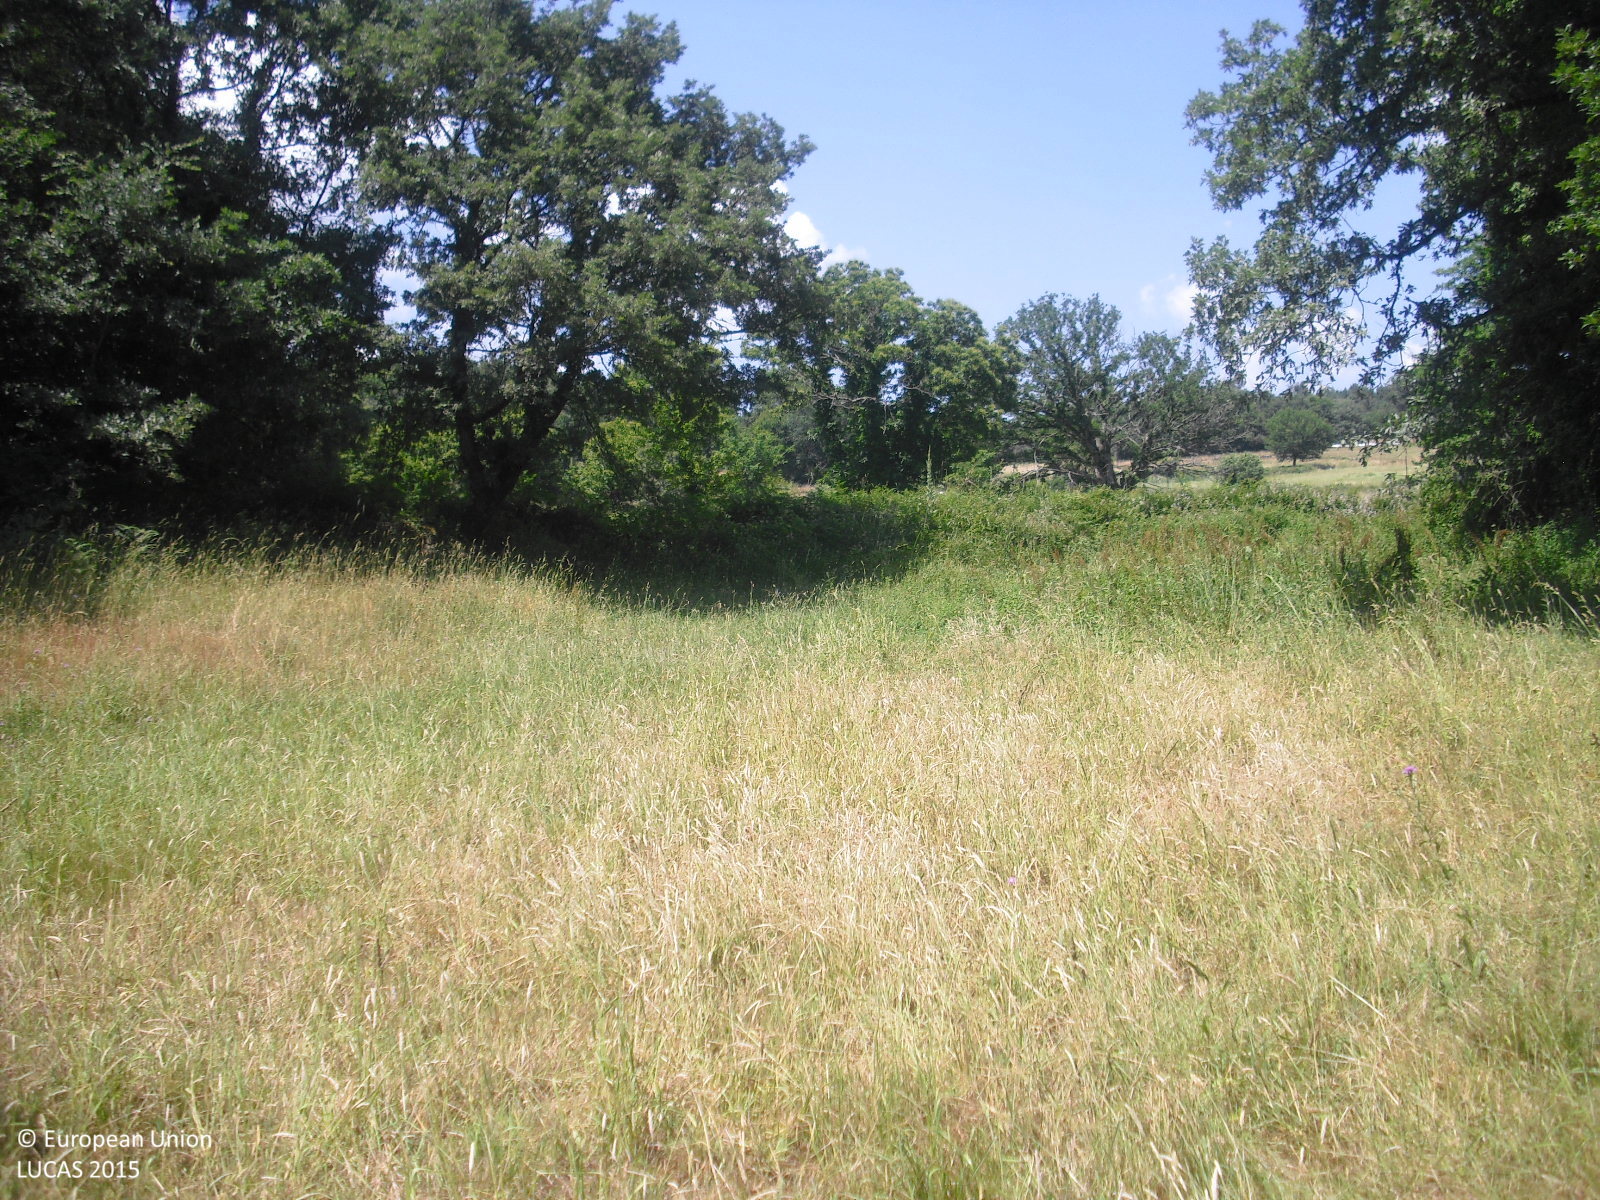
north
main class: Grassland
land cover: Grassland without tree/shrub cover
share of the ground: > 75 %
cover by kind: herbaceous plants 100 %
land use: Agriculture (excluding fallow land and kitchen gardens)
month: June
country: ES
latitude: 42.6658
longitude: -7.8077
